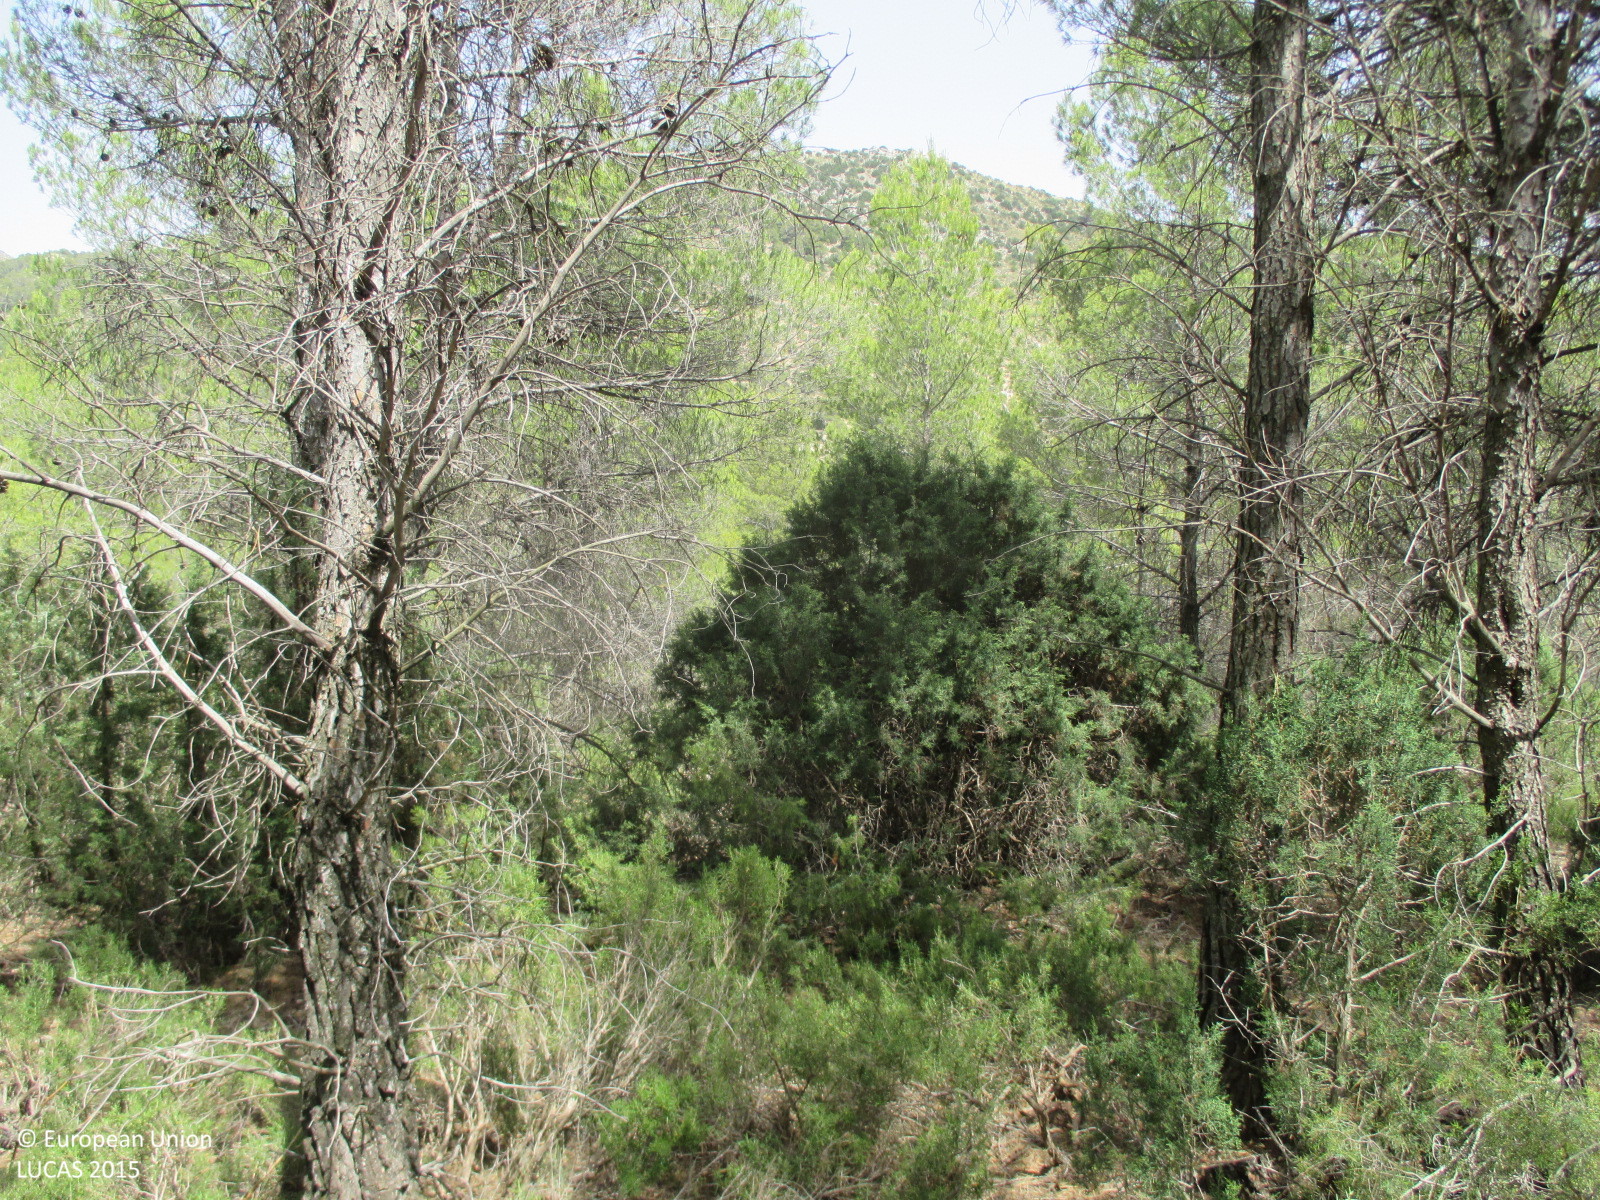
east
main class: Woodland
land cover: Pine dominated coniferous woodland
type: coniferous forest of the mediterranean region
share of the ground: > 75 %
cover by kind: coniferous forest trees 80 %, shrubs 10 %, herbaceous plants 10 %
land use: Forestry
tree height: > 5 m
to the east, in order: Pine dominated coniferous woodland; Paved roads, cycling and walking lanes; Grassland with sparse tree/shrub cover; Nuts trees; Grassland with sparse tree/shrub cover; Rivers and streams; Grassland with sparse tree/shrub cover; Nuts trees; Shrubland without tree cover
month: July
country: ES
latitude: 37.9396
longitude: -2.4048
